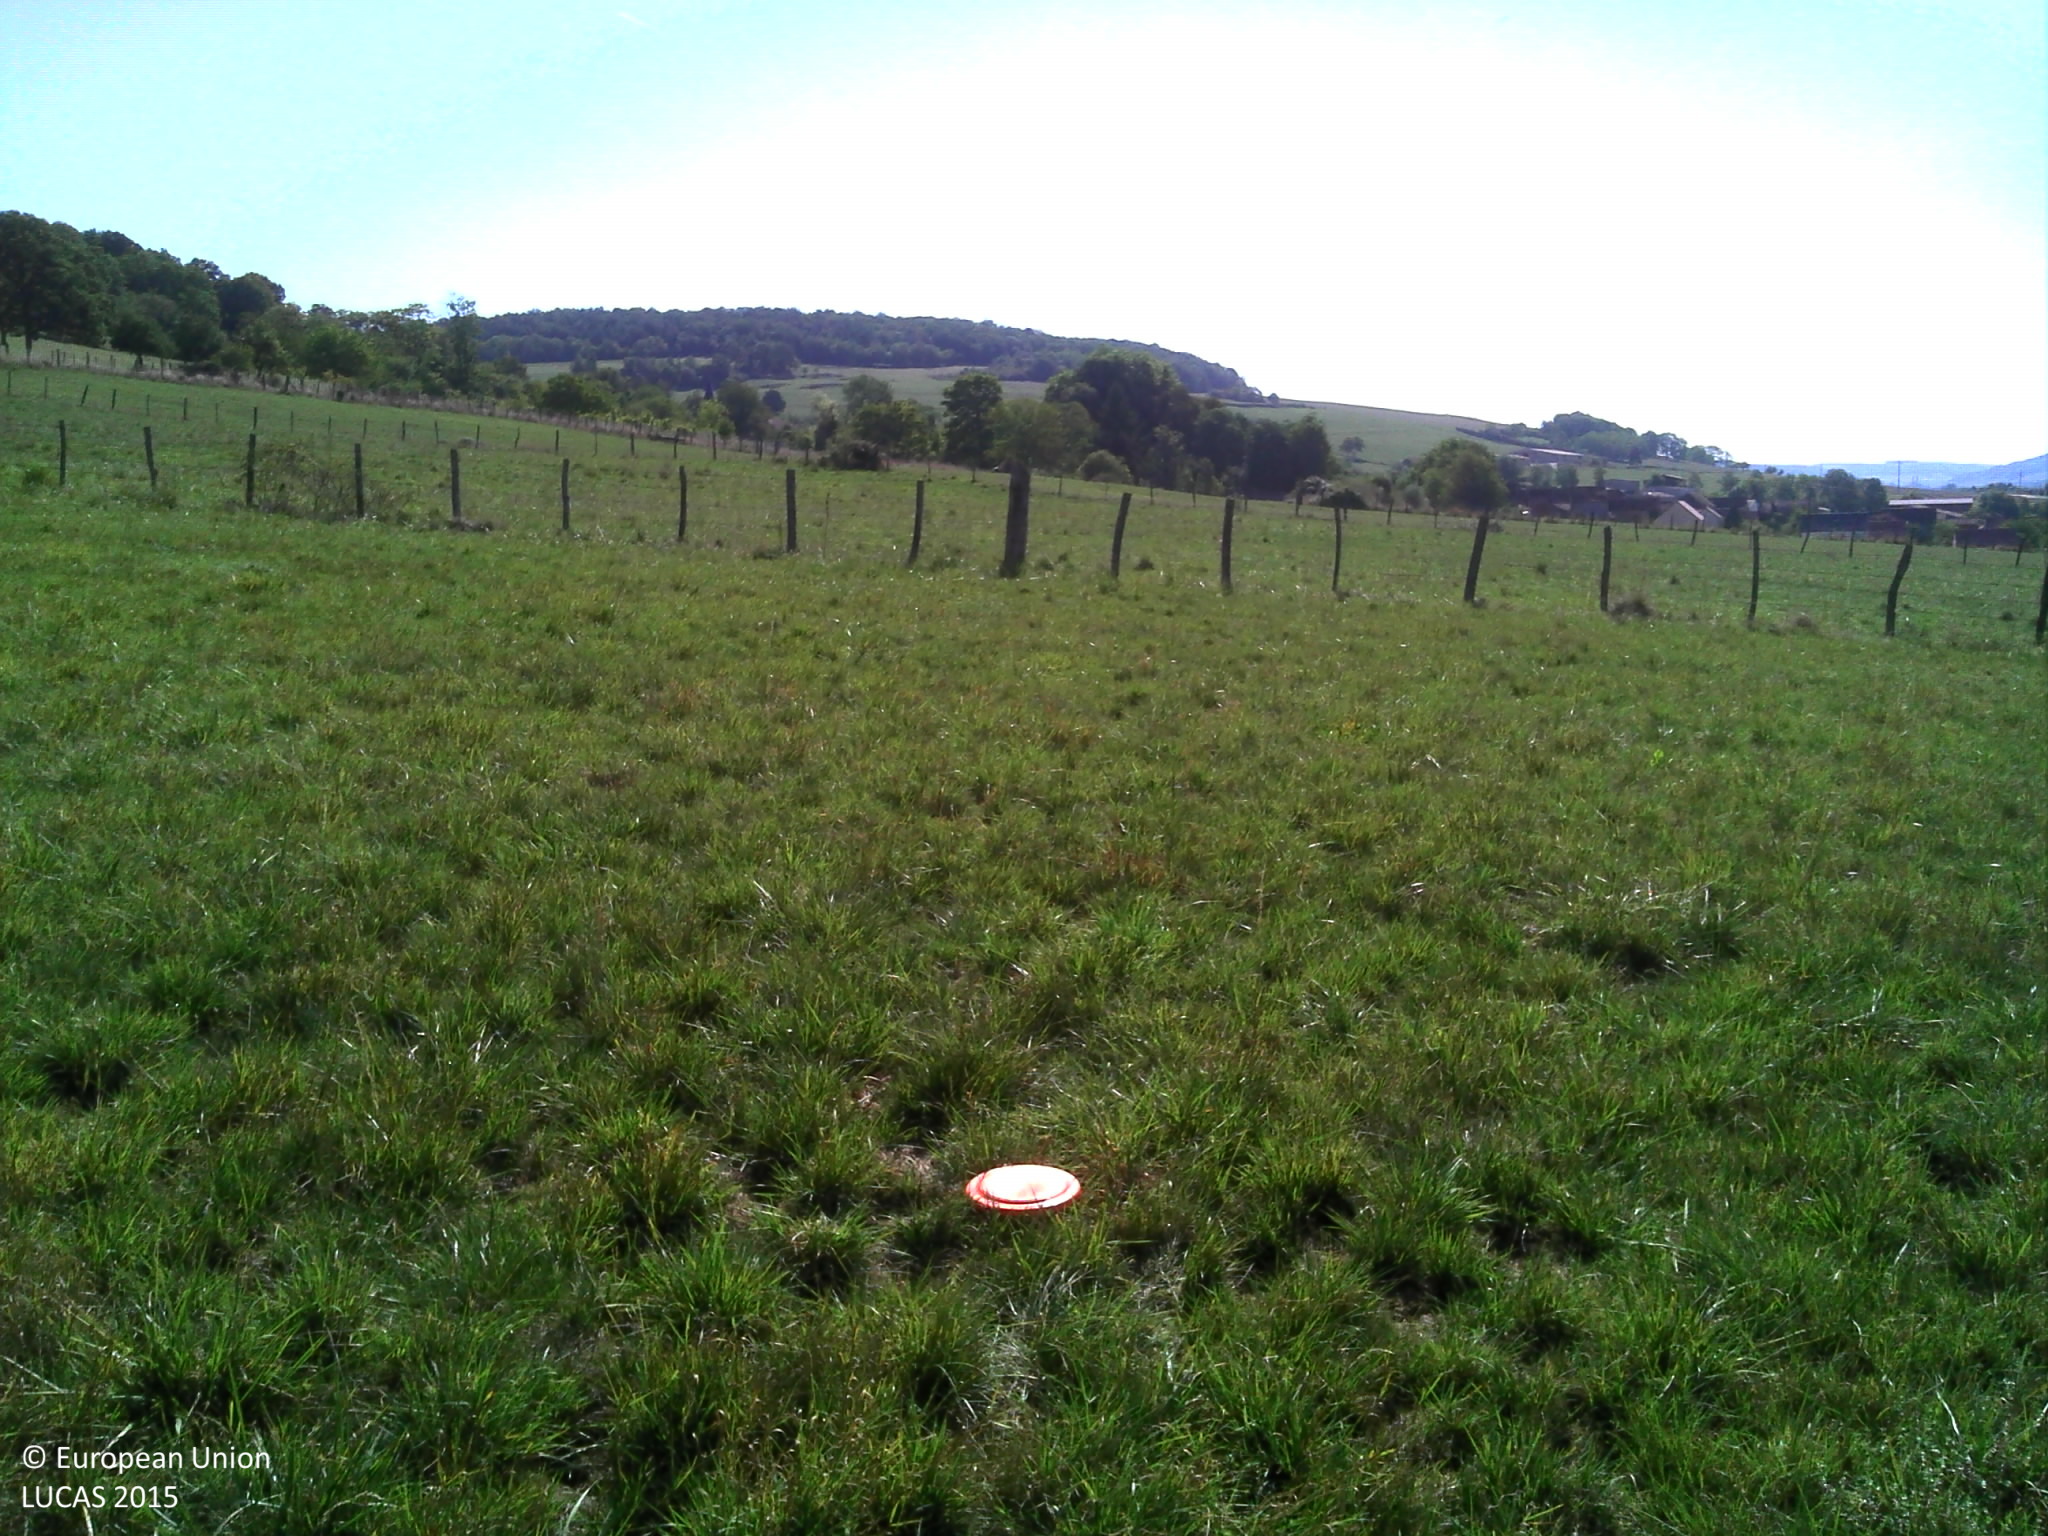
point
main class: Grassland
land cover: Grassland without tree/shrub cover
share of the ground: > 75 %
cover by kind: herbaceous plants 100 %
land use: Agriculture (excluding fallow land and kitchen gardens)
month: September
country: FR
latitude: 47.5776
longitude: 4.4283
